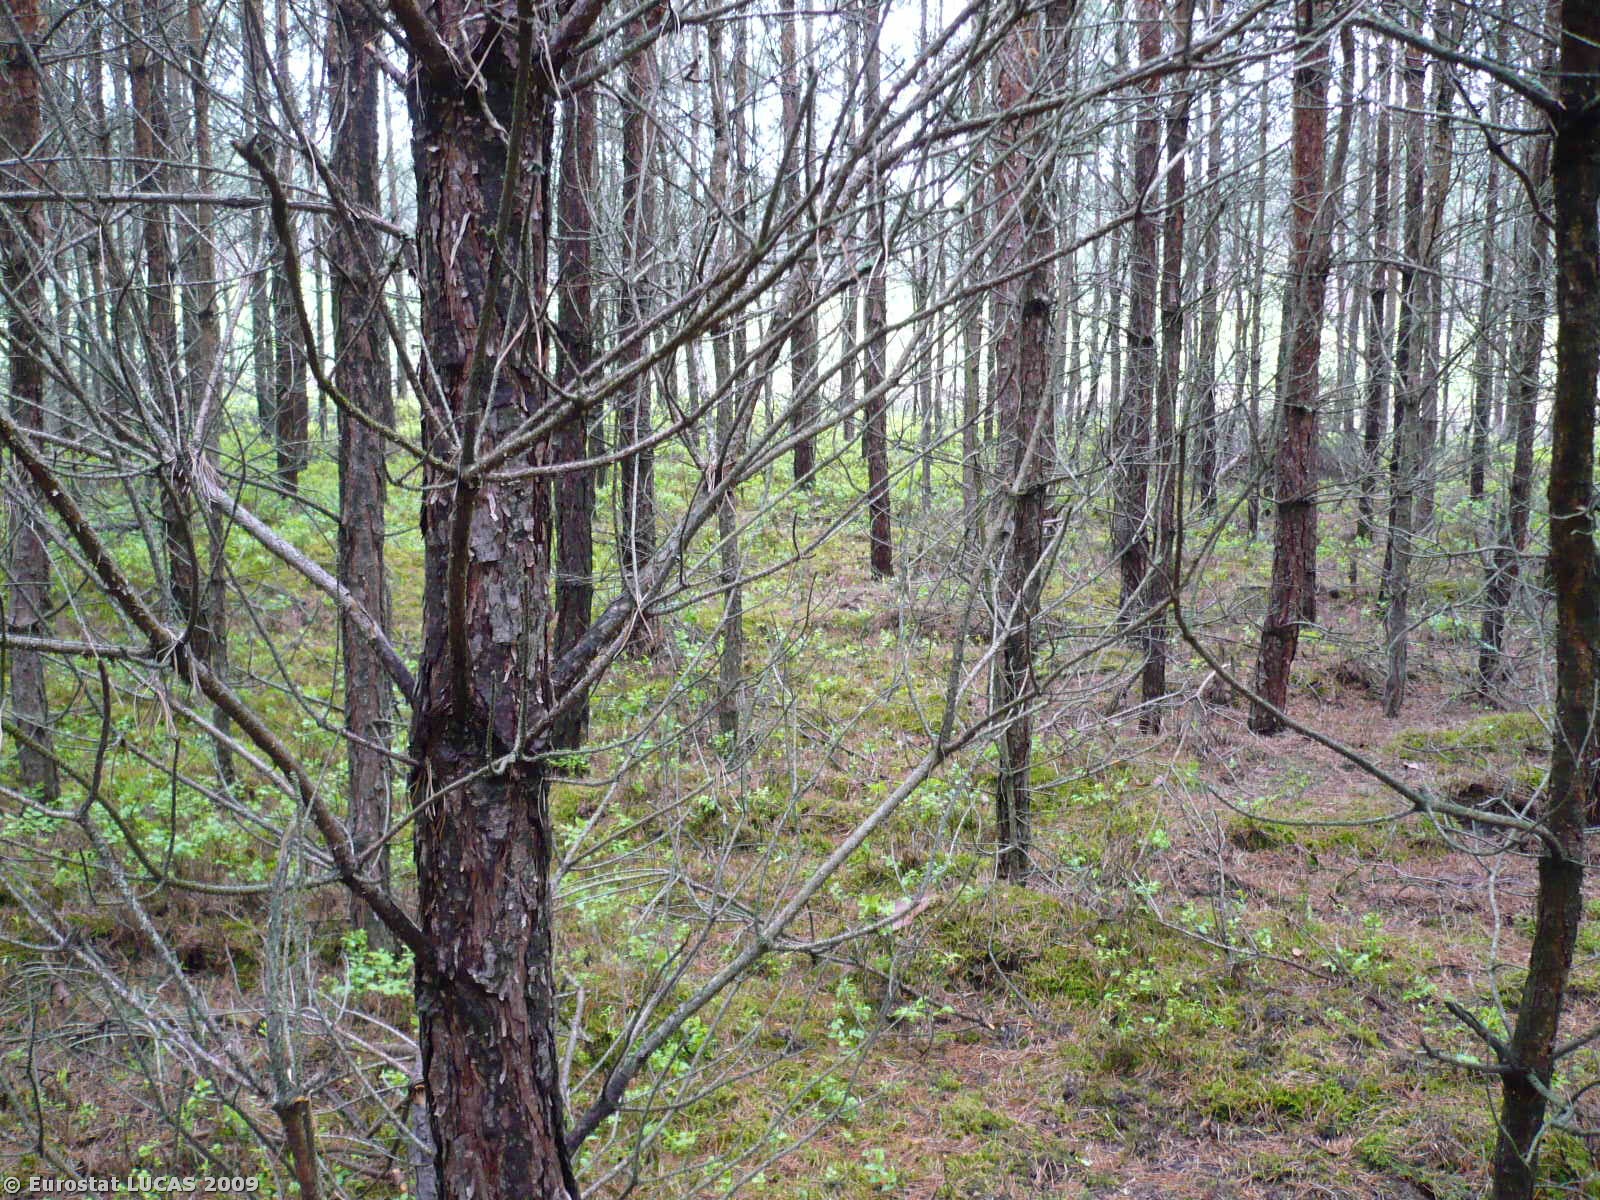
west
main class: Woodland
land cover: Coniferous woodland
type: hemiboreal forest and nemoral coniferous forest and mixed broadleaved-coniferous forest
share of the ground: > 75 %
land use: Forestry
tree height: > 5 m
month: May
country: PL
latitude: 51.9702
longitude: 15.3166
